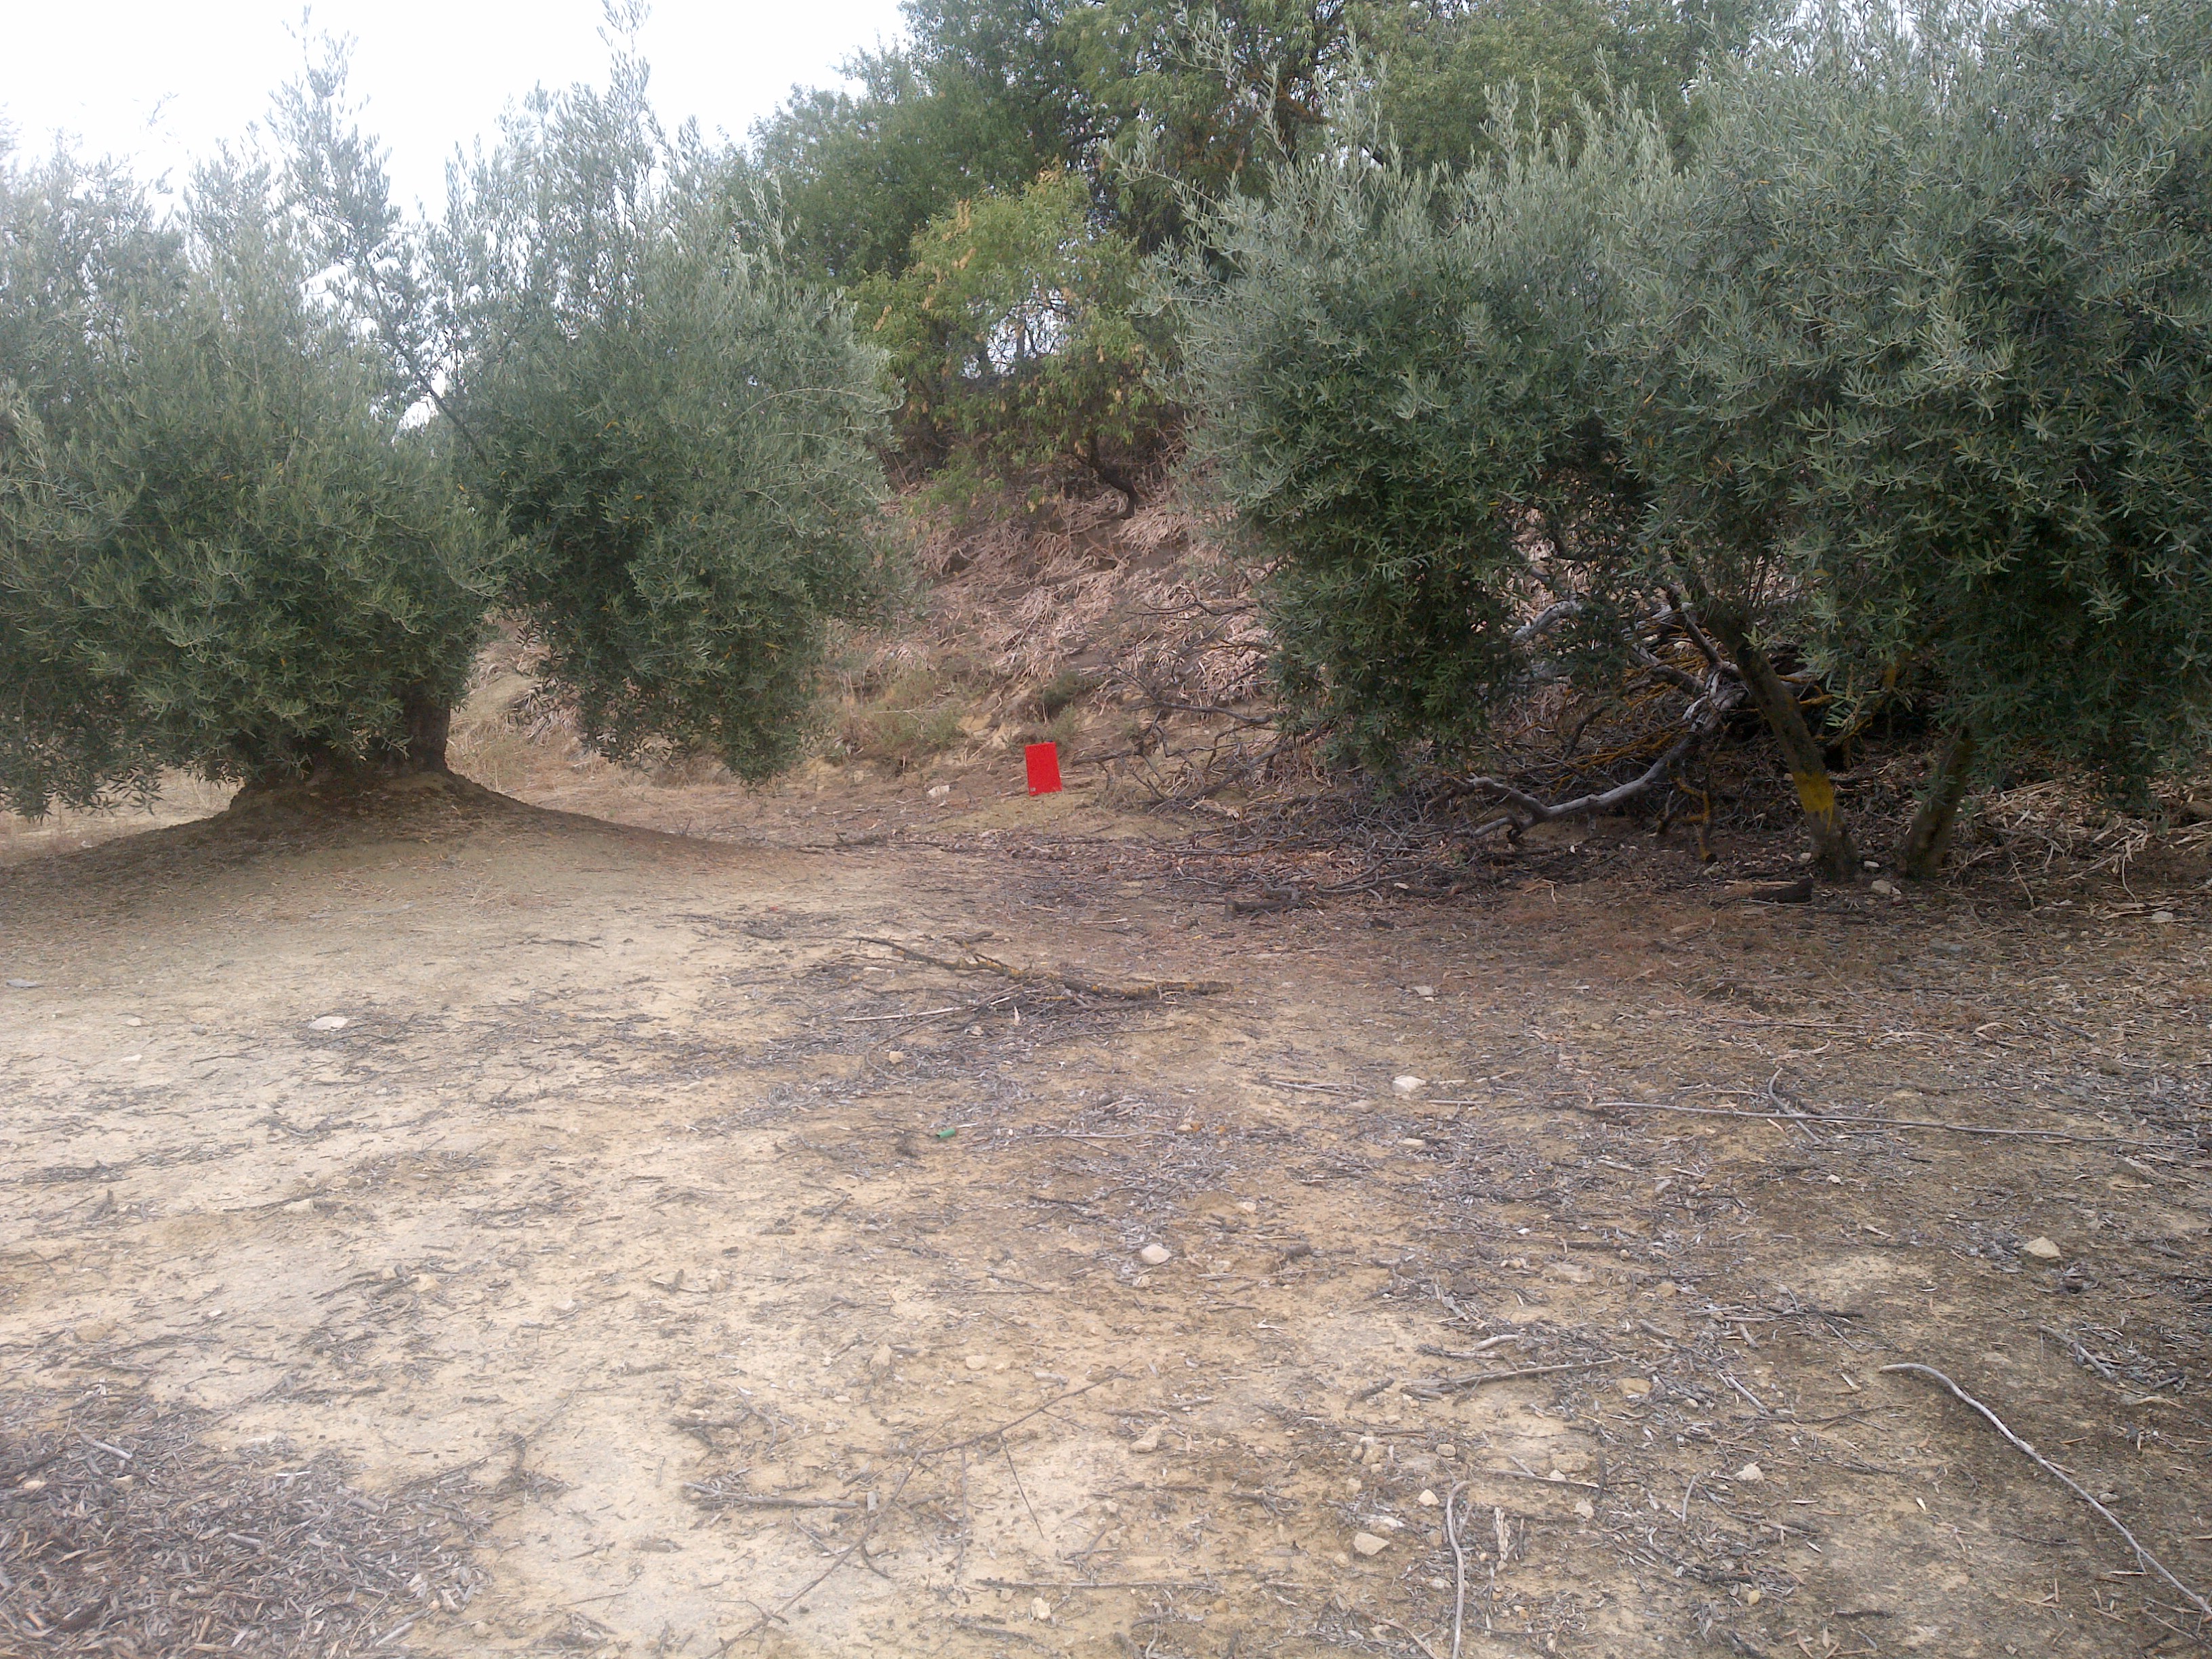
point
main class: Cropland
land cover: Olive groves
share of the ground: 25 - 50 %
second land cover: Other bare soil
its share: > 75 %
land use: Agriculture (excluding fallow land and kitchen gardens)
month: June
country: ES
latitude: 37.8240
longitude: -4.2647
